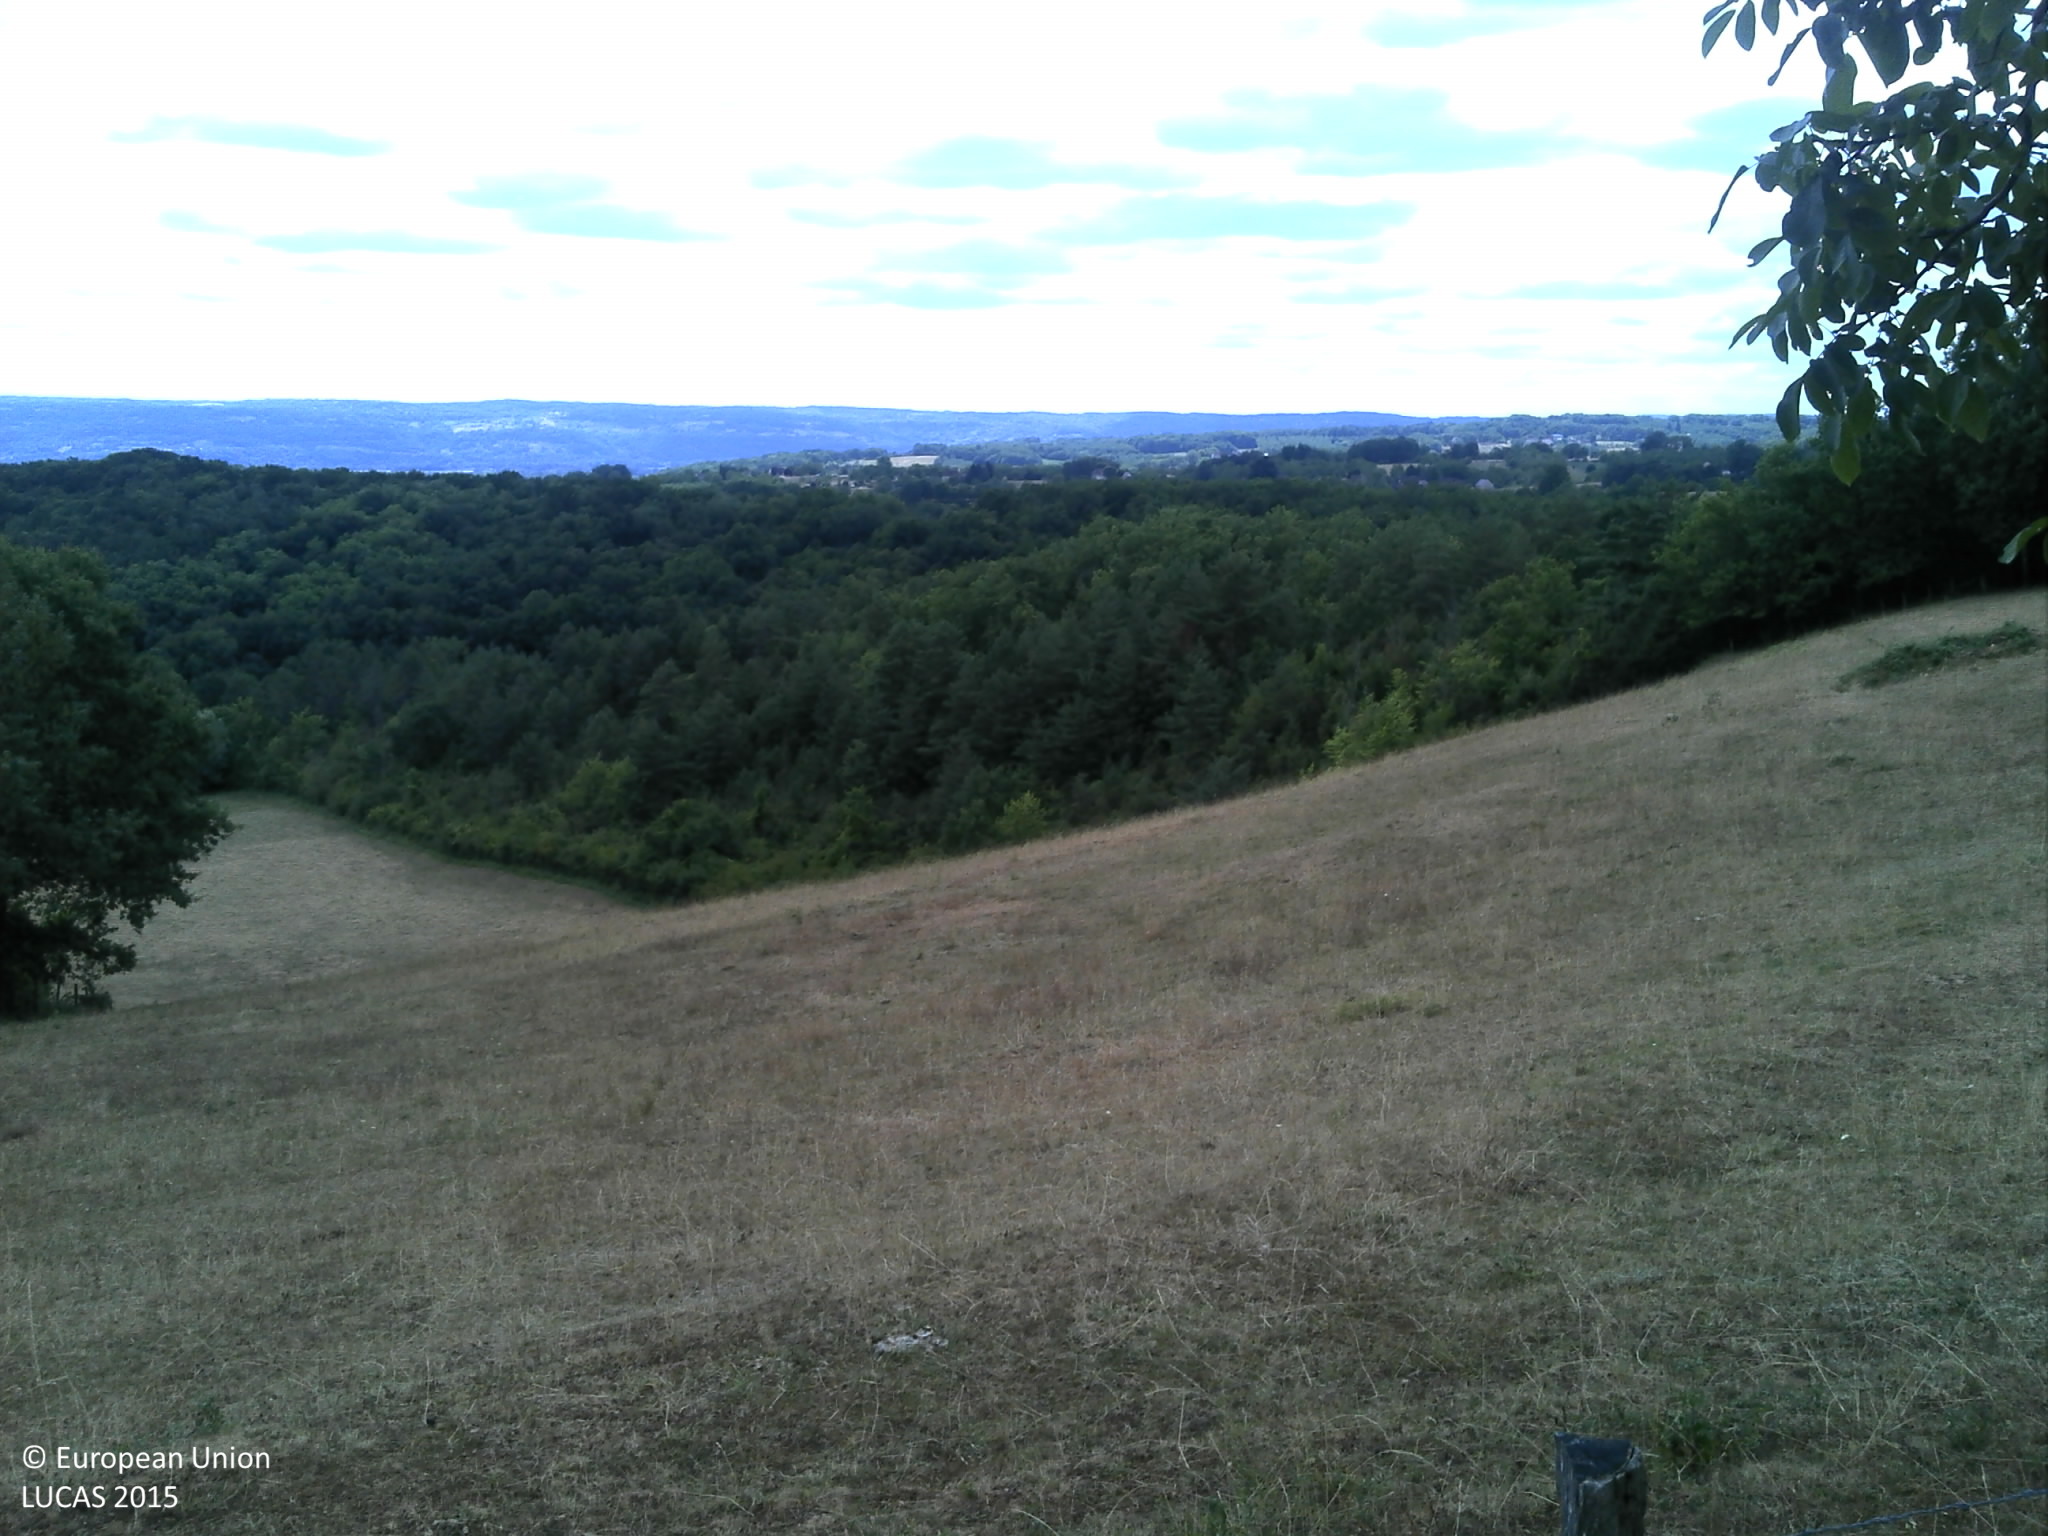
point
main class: Grassland
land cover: Grassland without tree/shrub cover
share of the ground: > 75 %
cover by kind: herbaceous plants 100 %
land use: Agriculture (excluding fallow land and kitchen gardens)
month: July
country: FR
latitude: 44.9513
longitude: 1.8222
